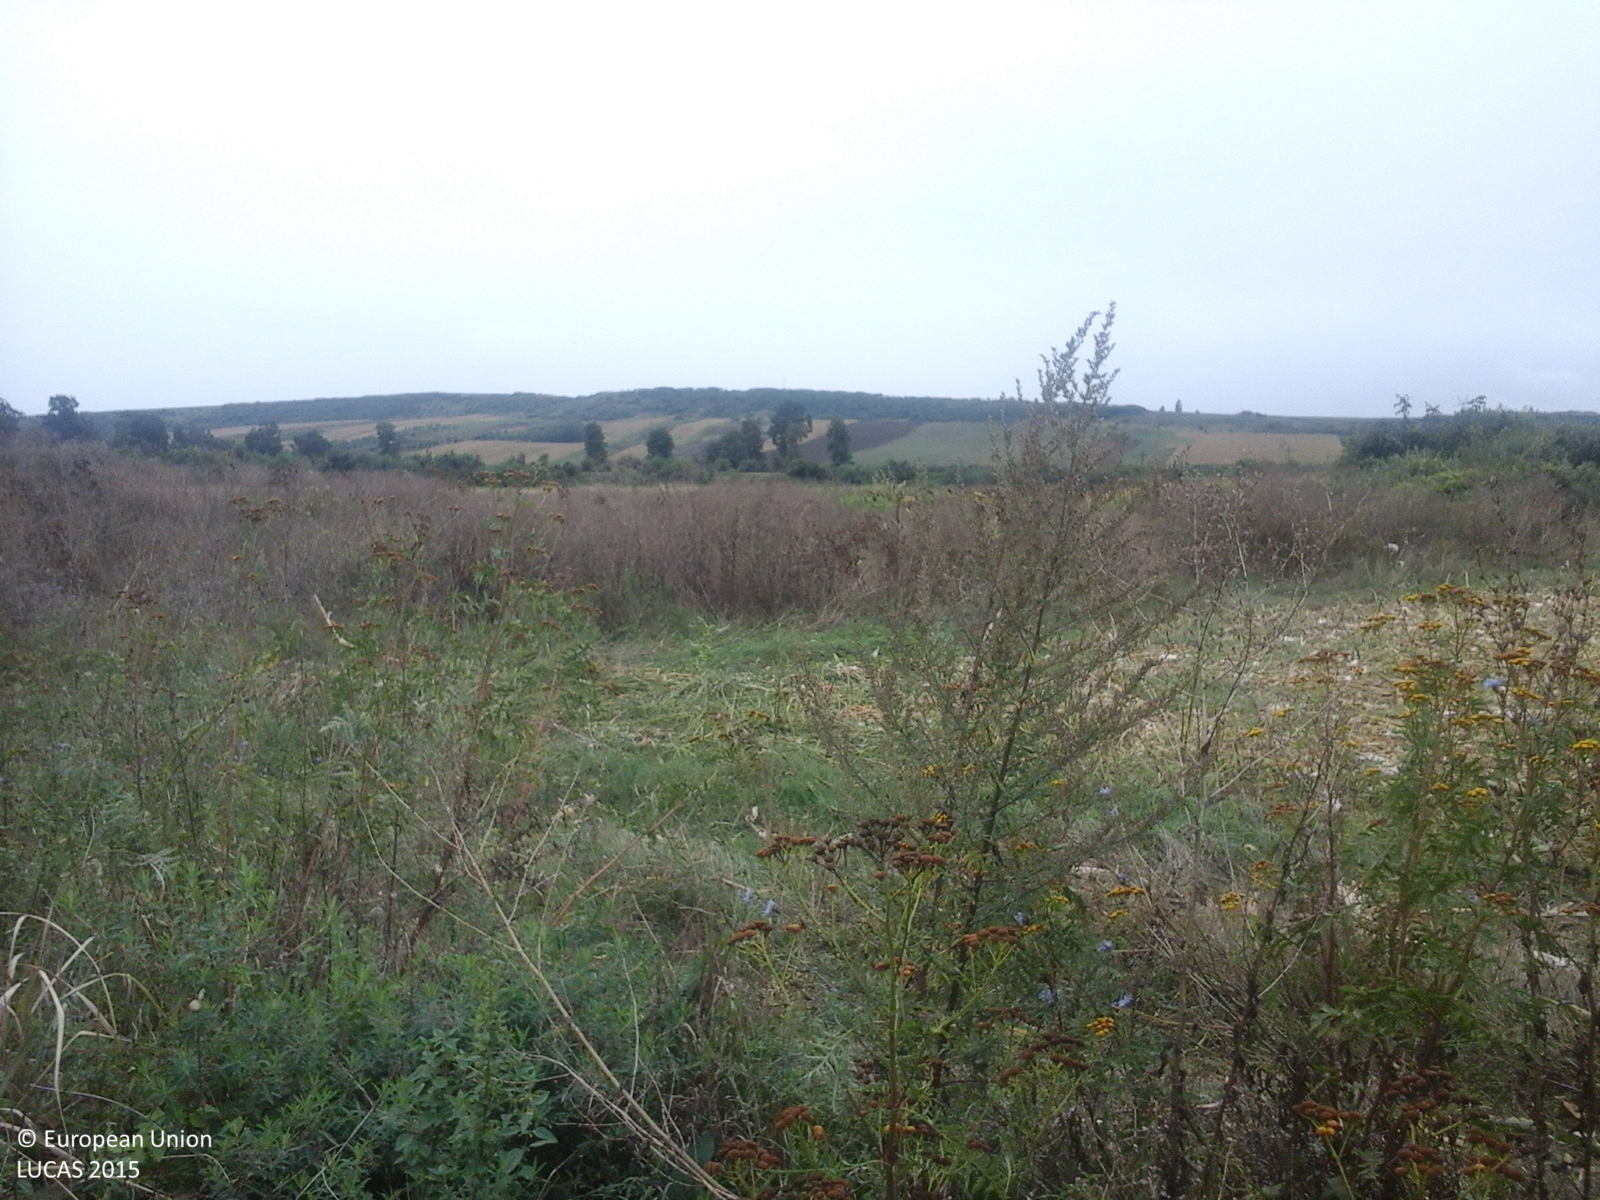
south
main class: Shrubland
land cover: Shrubland with sparse tree cover
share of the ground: > 75 %
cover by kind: shrubs 75 %, herbaceous plants 20 %, broadleaved forest trees 5 %
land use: Semi-natural and natural areas not in use
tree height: < 5 m
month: September
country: RO
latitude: 47.3233
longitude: 22.0499
